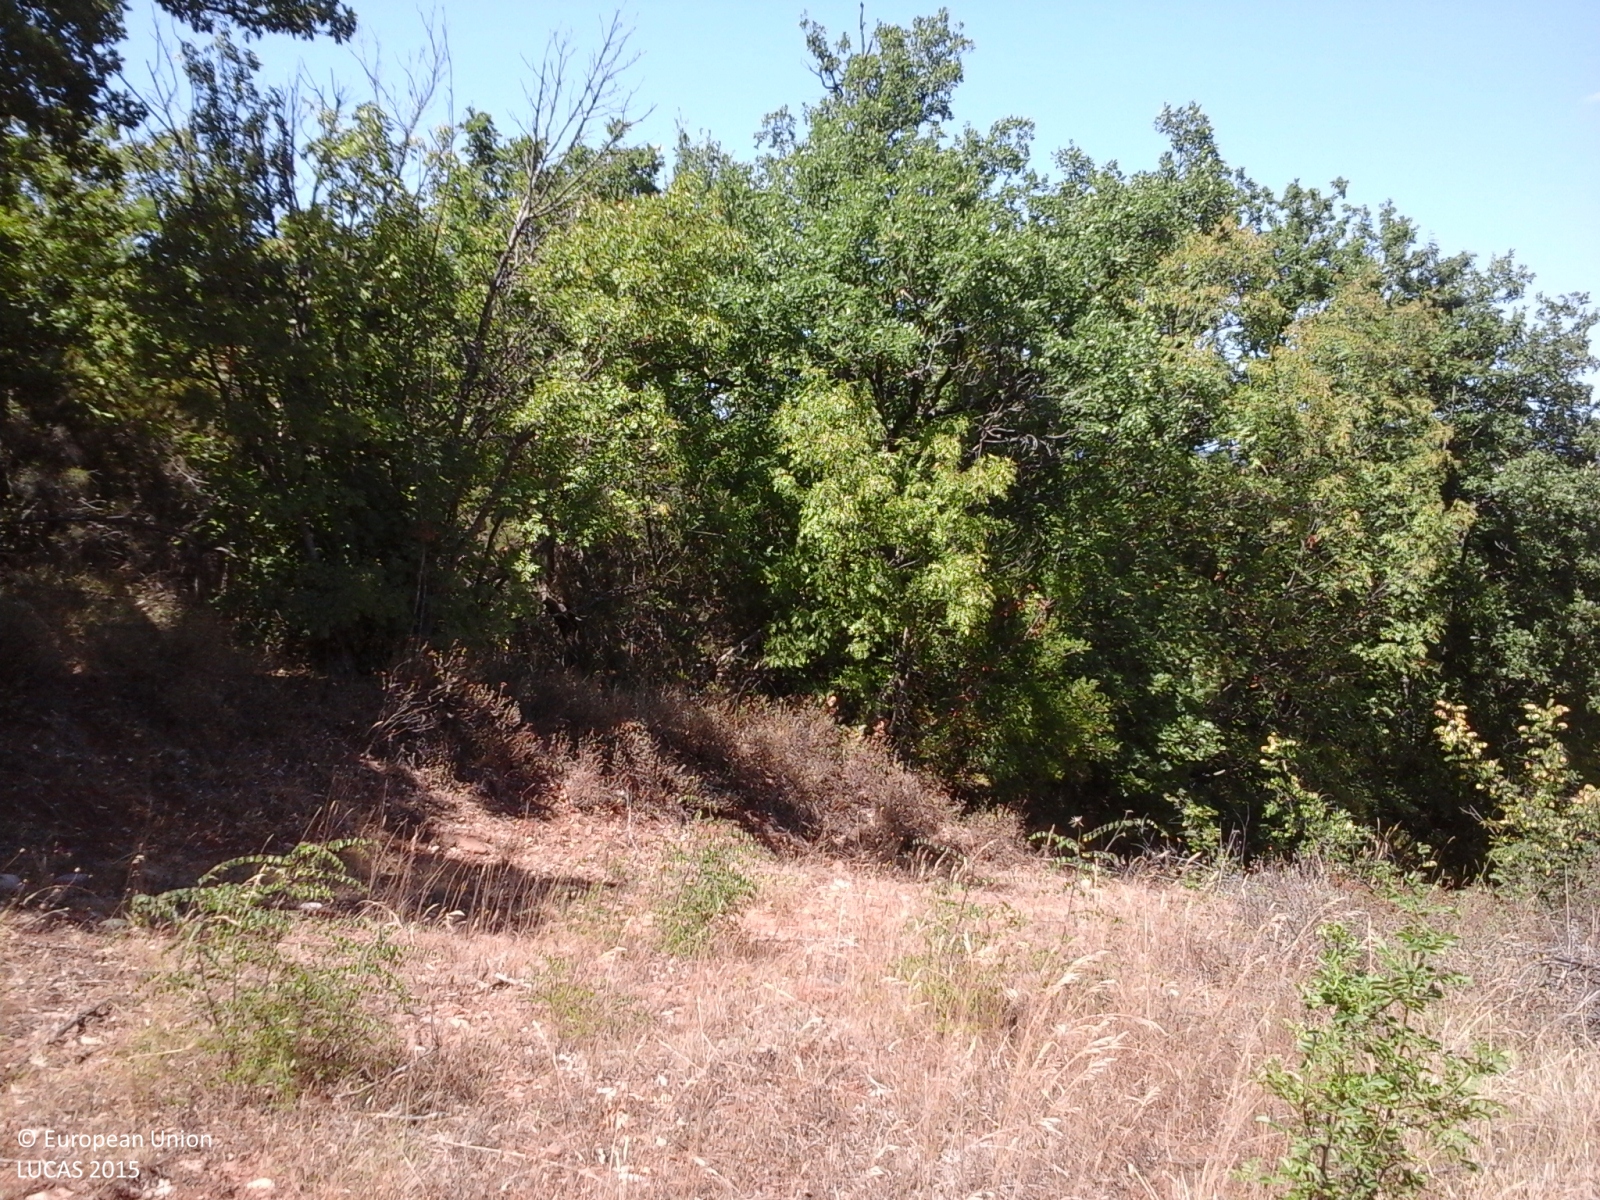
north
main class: Woodland
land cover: Broadleaved woodland
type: thermophilous deciduous forest
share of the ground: > 75 %
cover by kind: broadleaved forest trees 75 %, shrubs 20 %, herbaceous plants 5 %
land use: Forestry
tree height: > 5 m
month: August
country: IT
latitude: 42.6238
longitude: 11.5676
